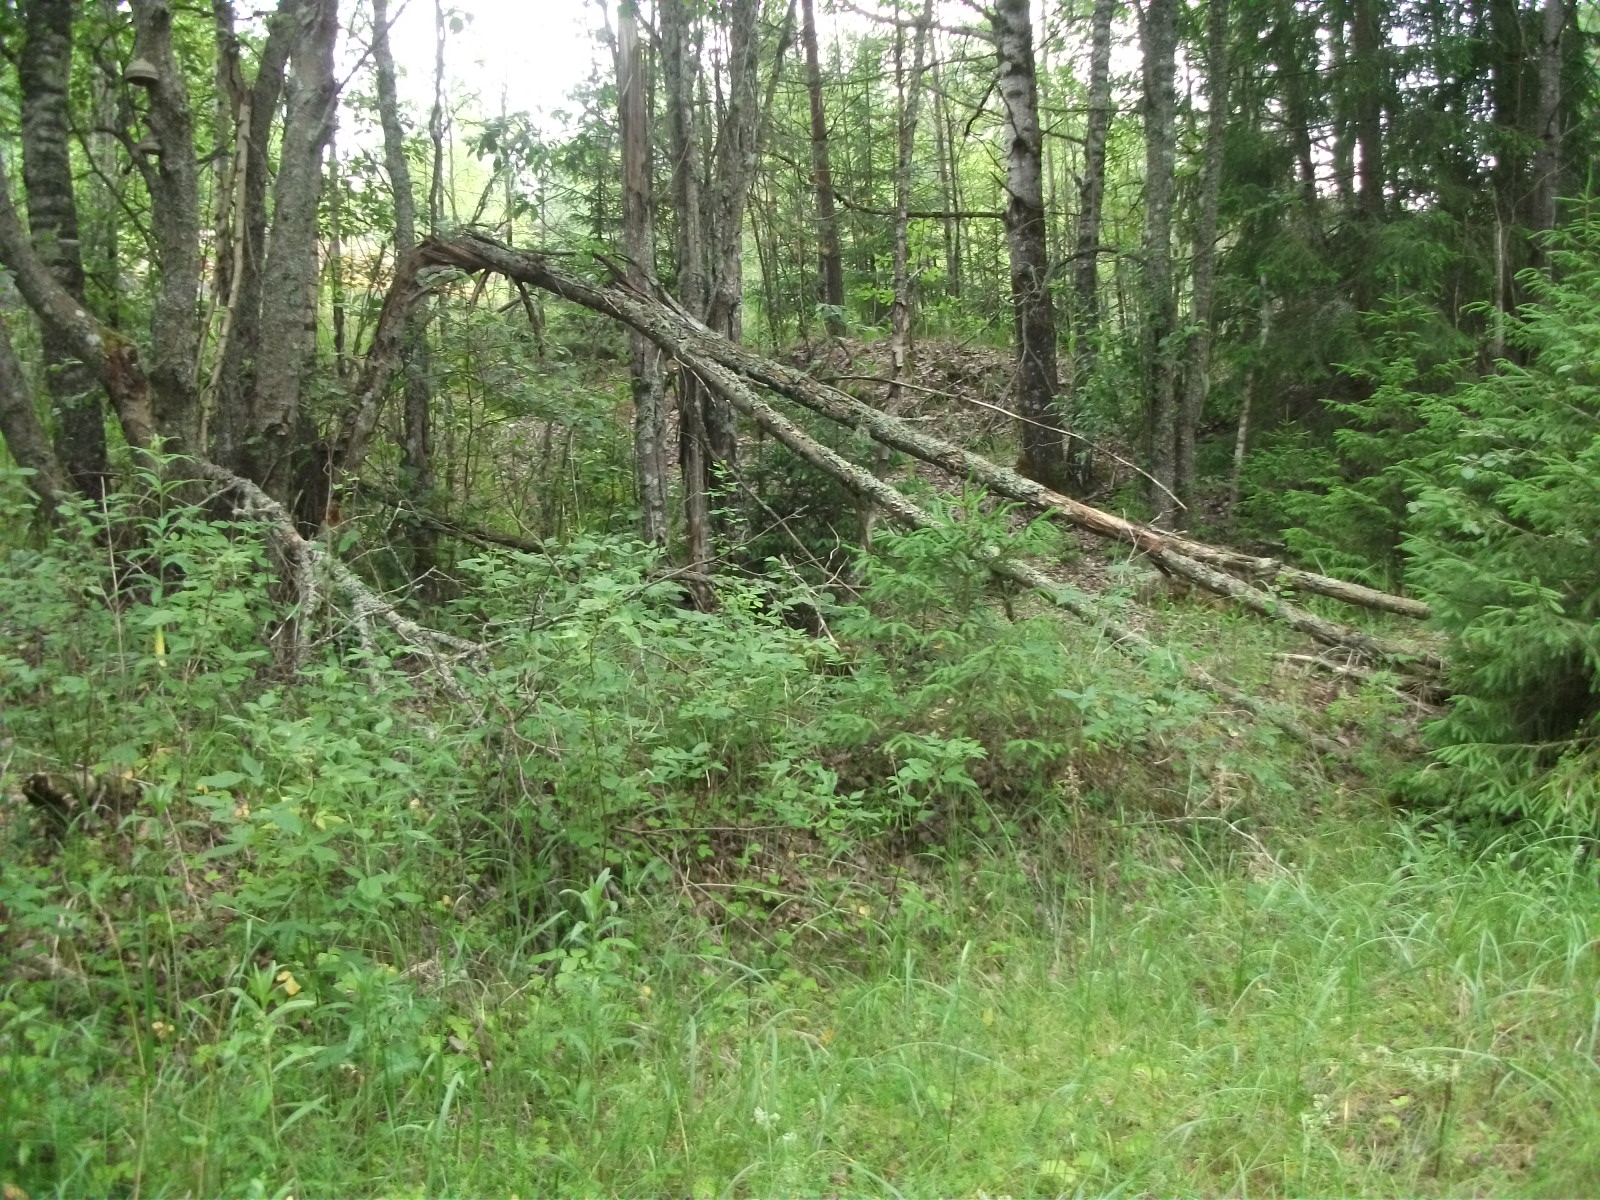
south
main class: Woodland
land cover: Spruce dominated mixed woodland
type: hemiboreal forest and nemoral coniferous forest and mixed broadleaved-coniferous forest
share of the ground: 50 - 75 %
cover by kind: coniferous forest trees 45 %, broadleaved forest trees 25 %, shrubs 10 %, herbaceous plants 10 %, lichens and mosses 10 %
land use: Forestry
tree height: > 5 m
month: July
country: LV
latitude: 57.2182
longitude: 26.5566
